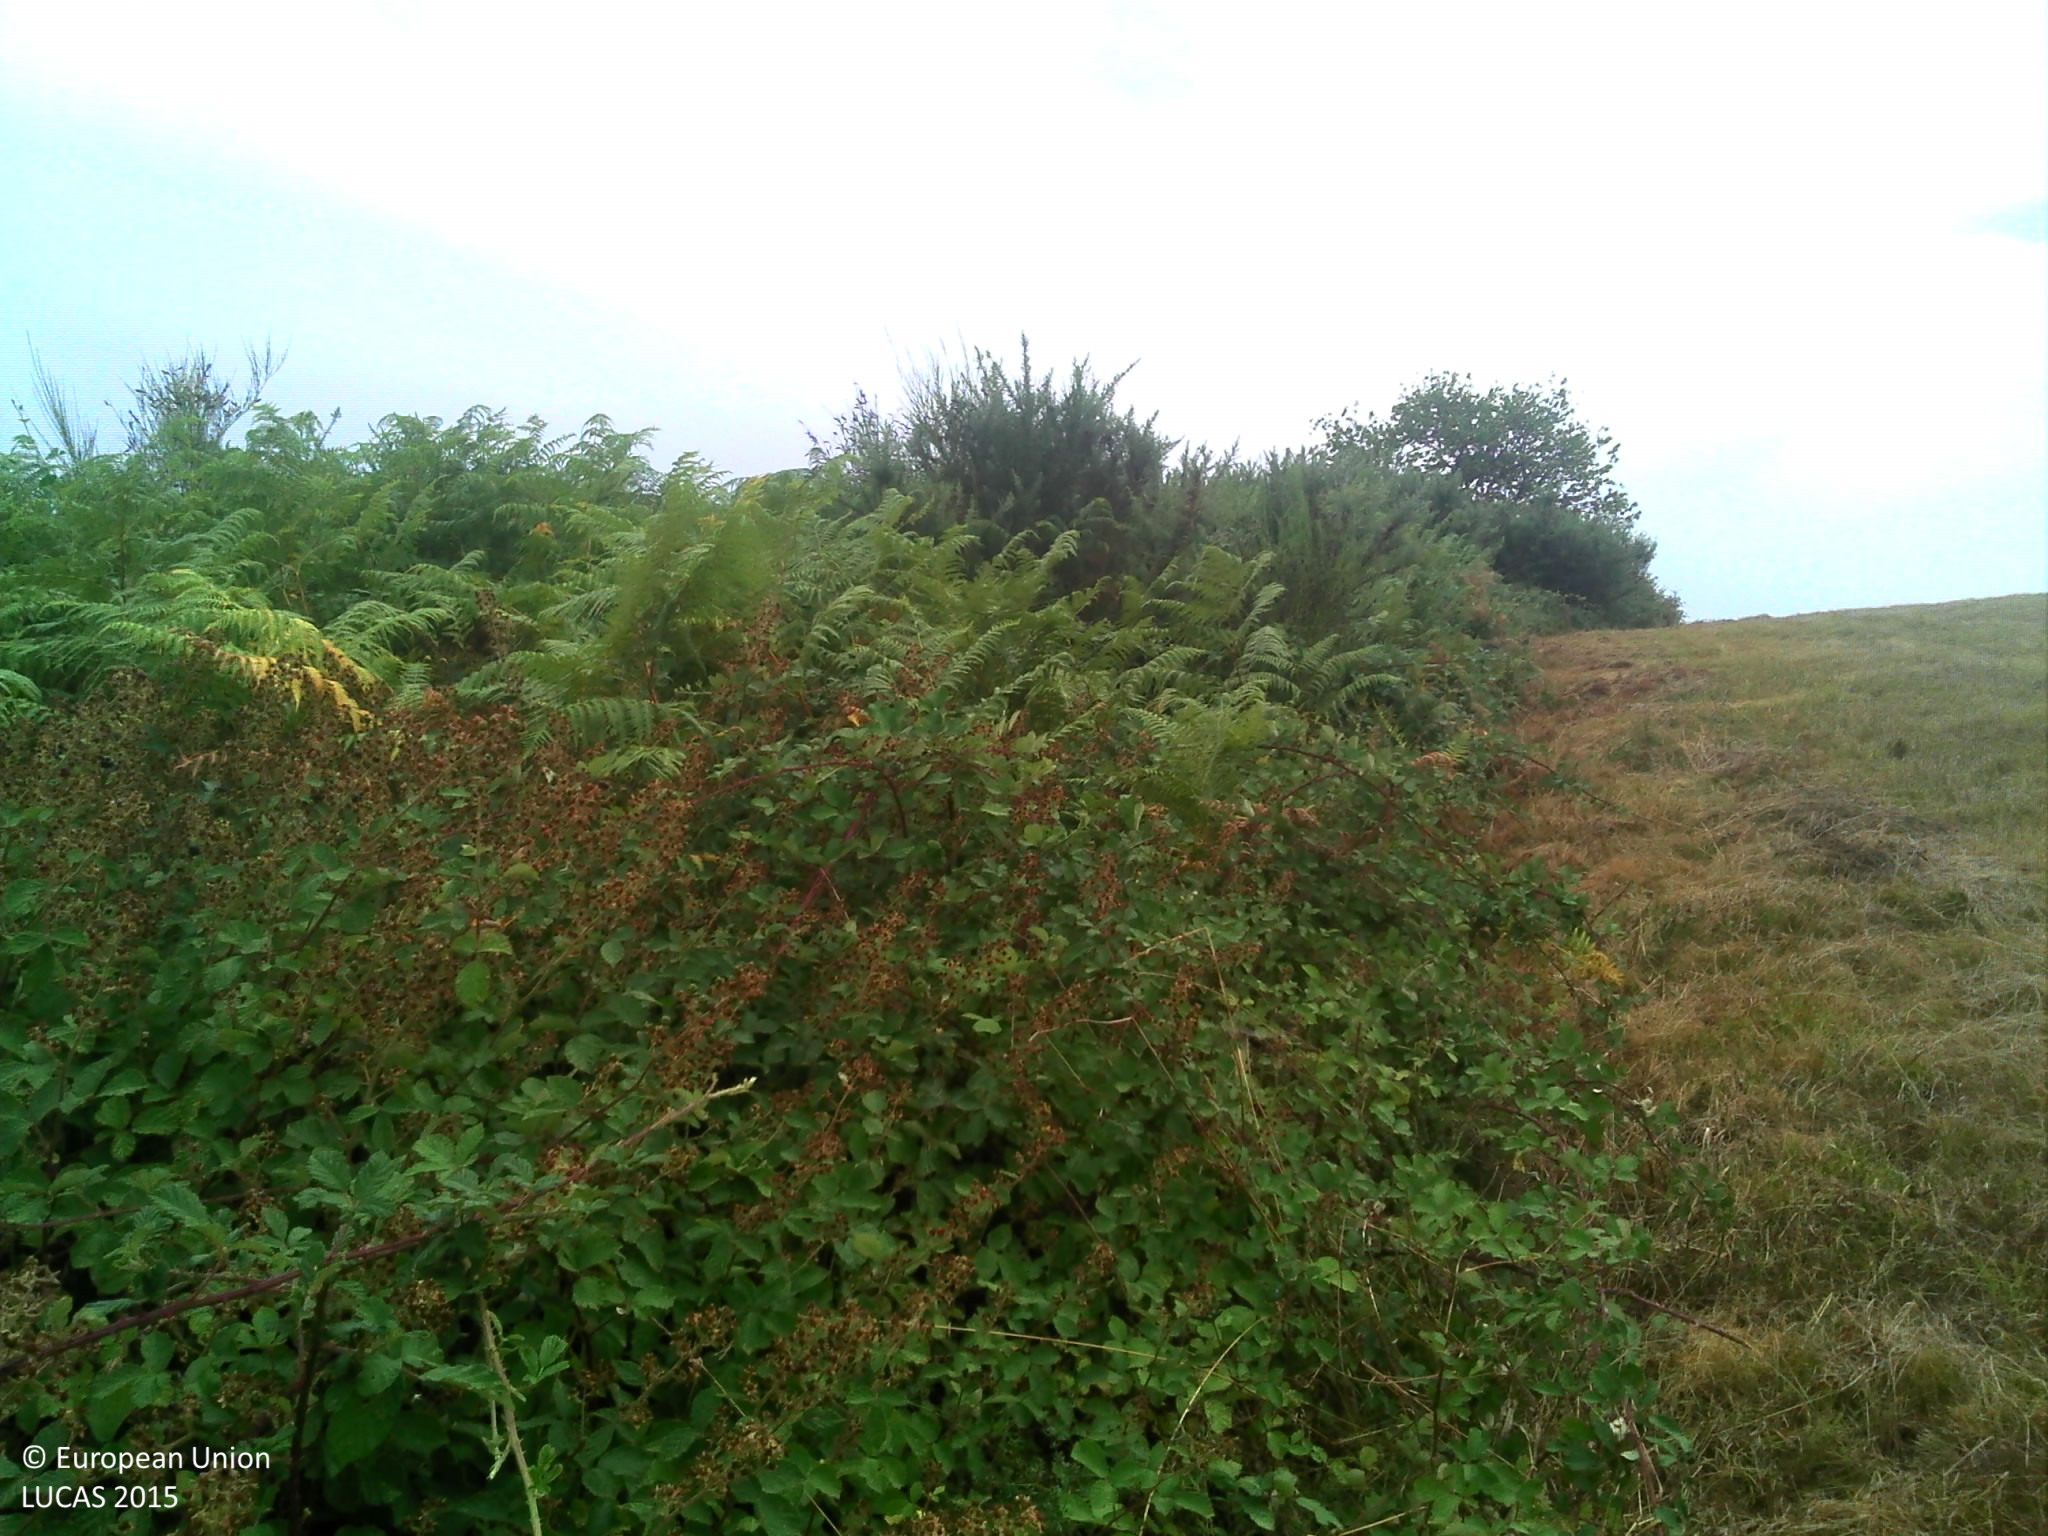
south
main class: Shrubland
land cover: Shrubland without tree cover
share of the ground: > 75 %
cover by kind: shrubs 100 %
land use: Semi-natural and natural areas not in use
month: July
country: FR
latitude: 43.1755
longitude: 0.7630
